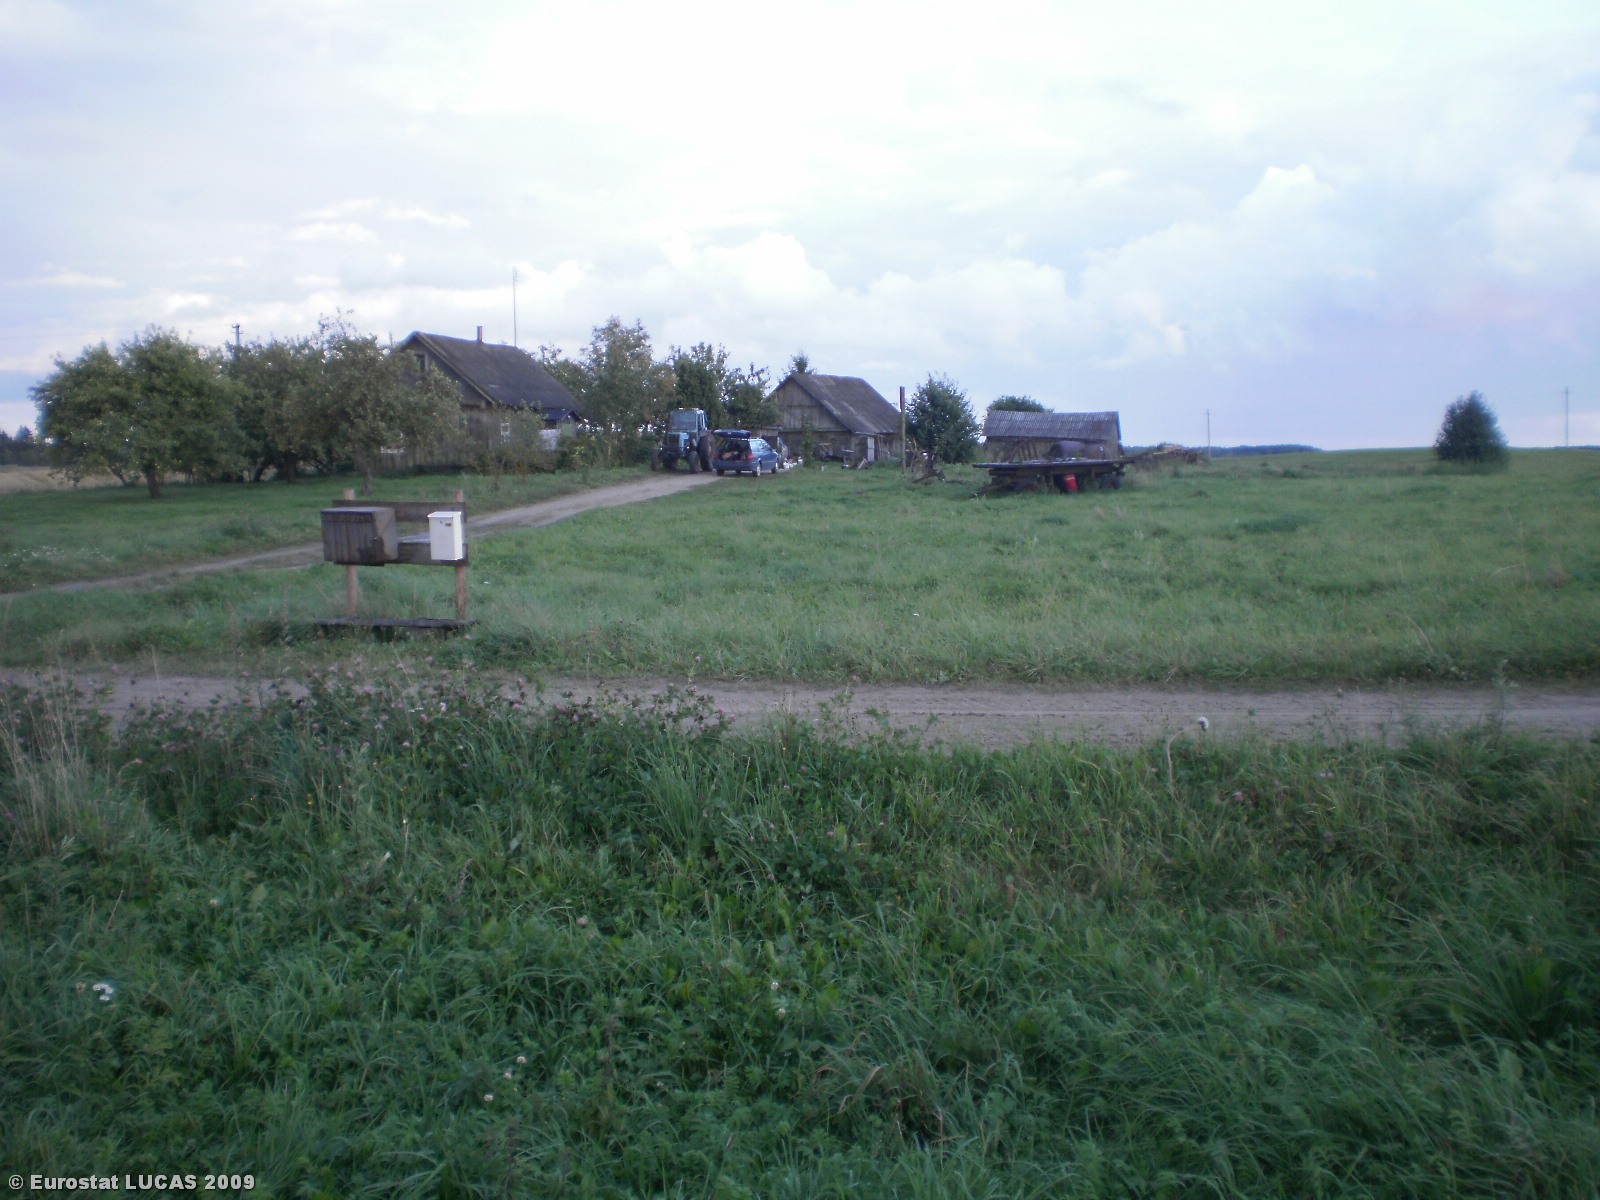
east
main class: Grassland
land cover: Grassland without tree/shrub cover
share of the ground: > 75 %
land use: Agriculture (excluding fallow land and kitchen gardens)
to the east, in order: Grassland without tree/shrub cover; Paved roads, cycling and walking lanes; Grassland without tree/shrub cover; Tracks; Broadleaved woodland; Potatoes; Grassland without tree/shrub cover; Tracks; Grassland without tree/shrub cover
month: August
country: LT
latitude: 55.0872
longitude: 25.5272
